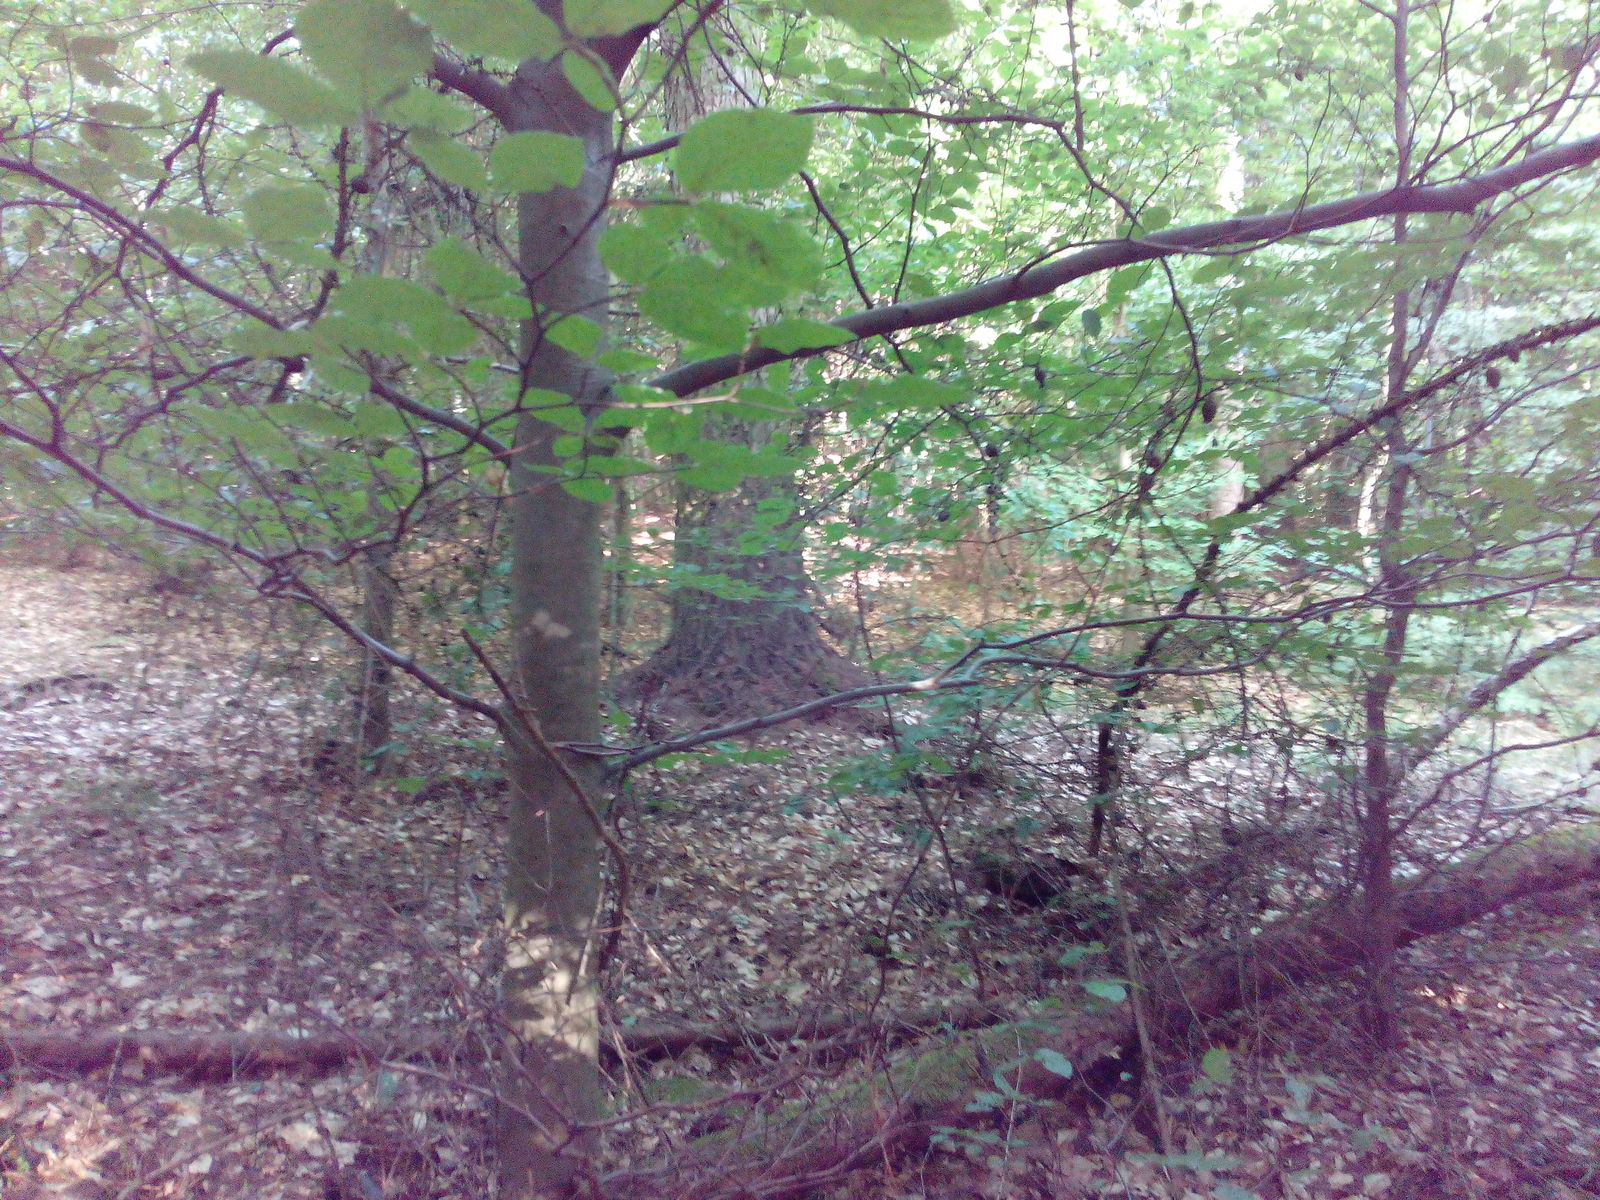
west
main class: Woodland
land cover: Other mixed woodland
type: hemiboreal forest and nemoral coniferous forest and mixed broadleaved-coniferous forest
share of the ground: 50 - 75 %
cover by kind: broadleaved forest trees 70 %, coniferous forest trees 30 %
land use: Forestry
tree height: > 5 m
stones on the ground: < 10 %
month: July
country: DE
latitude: 51.3130
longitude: 10.9610
